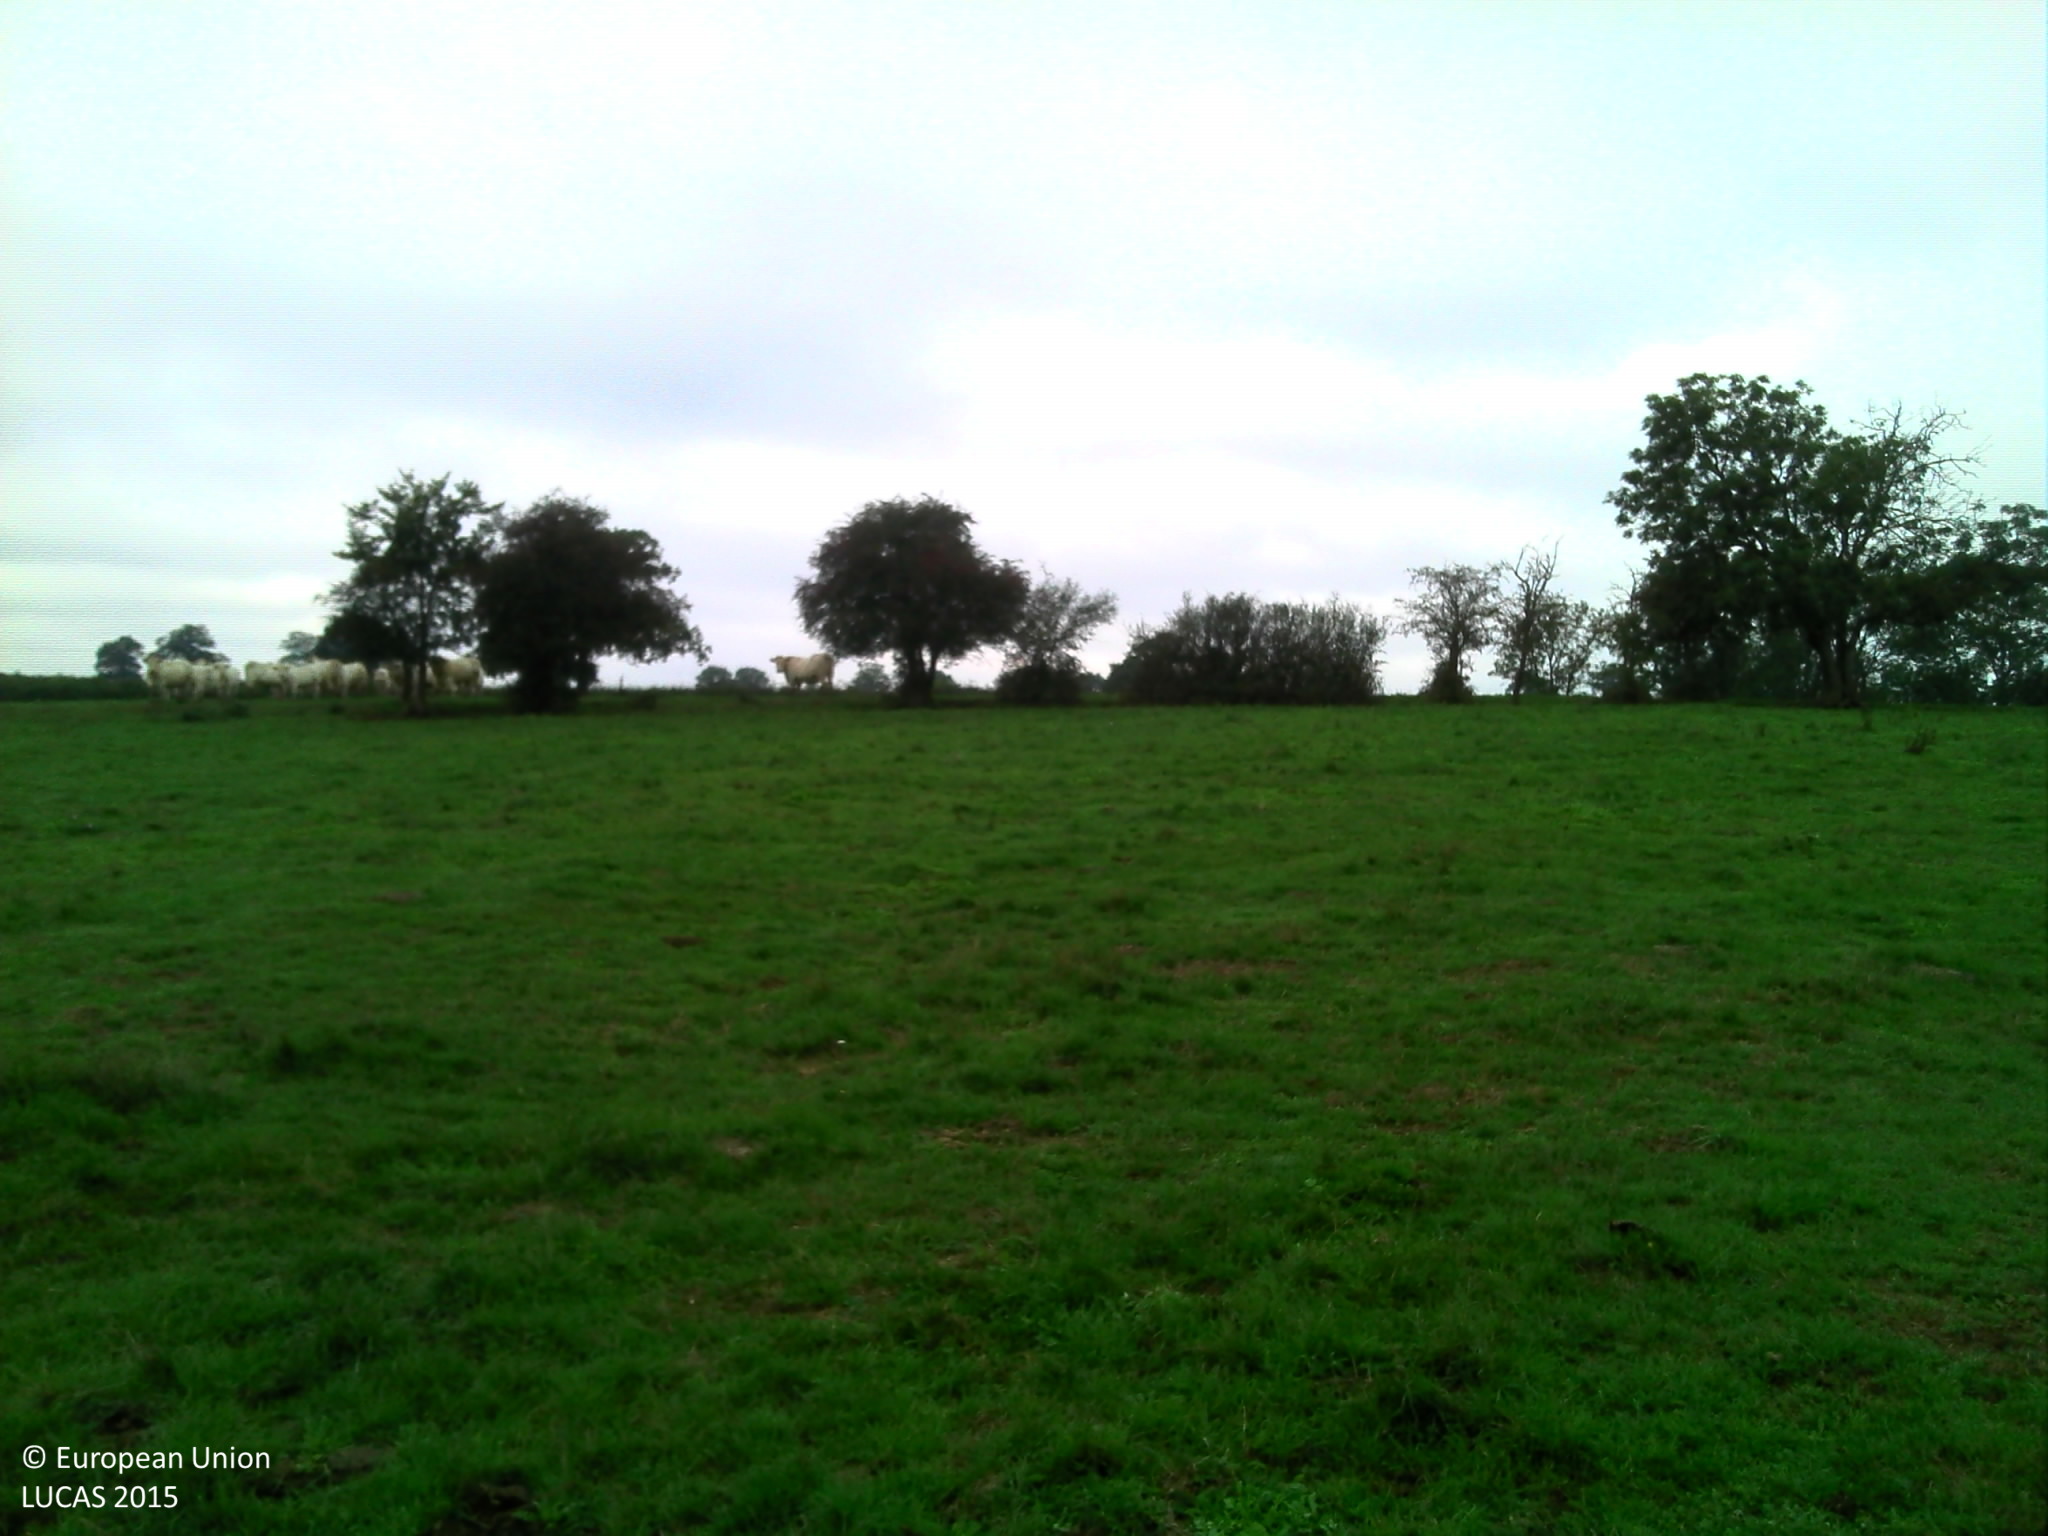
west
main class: Grassland
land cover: Grassland without tree/shrub cover
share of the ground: > 75 %
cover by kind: herbaceous plants 100 %
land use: Agriculture (excluding fallow land and kitchen gardens)
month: September
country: FR
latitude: 47.1649
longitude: 4.4724
